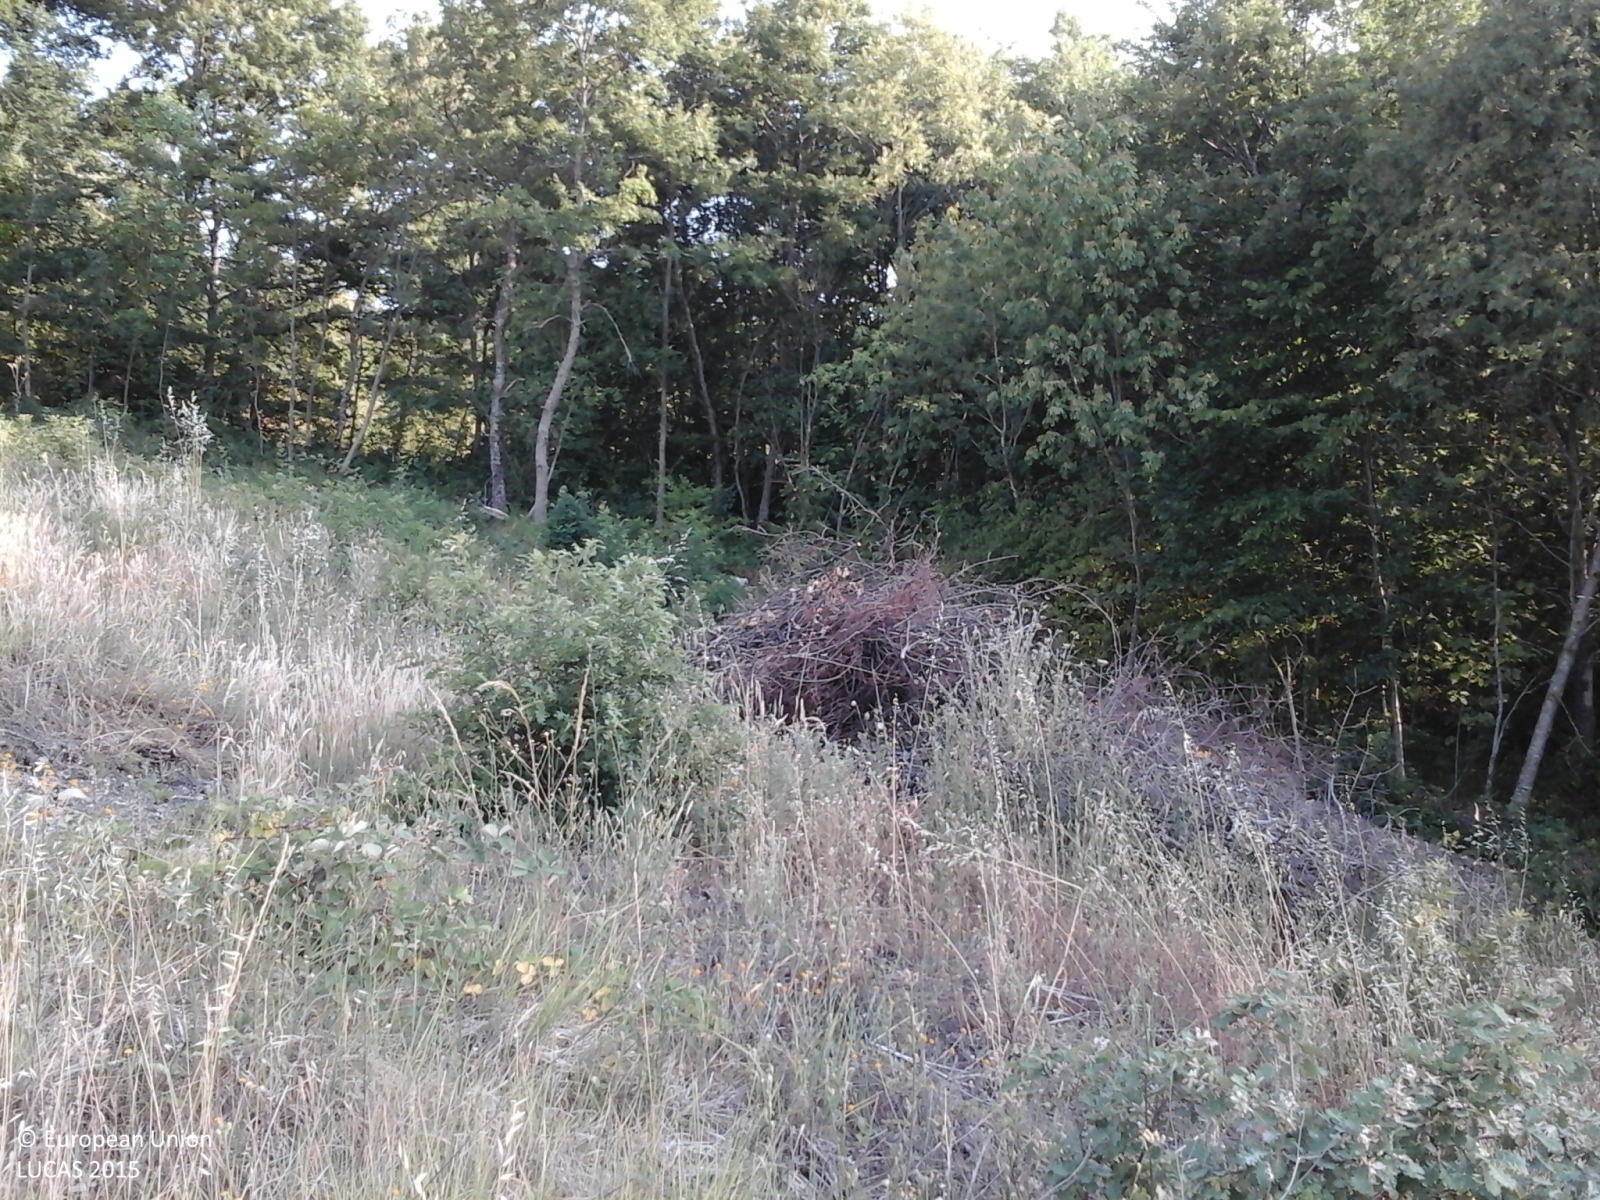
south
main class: Grassland
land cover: Grassland with sparse tree/shrub cover
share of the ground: > 75 %
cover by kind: herbaceous plants 90 %, broadleaved forest trees 5 %, shrubs 5 %
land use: Agriculture (excluding fallow land and kitchen gardens)
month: July
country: IT
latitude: 41.4946
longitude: 14.7149
